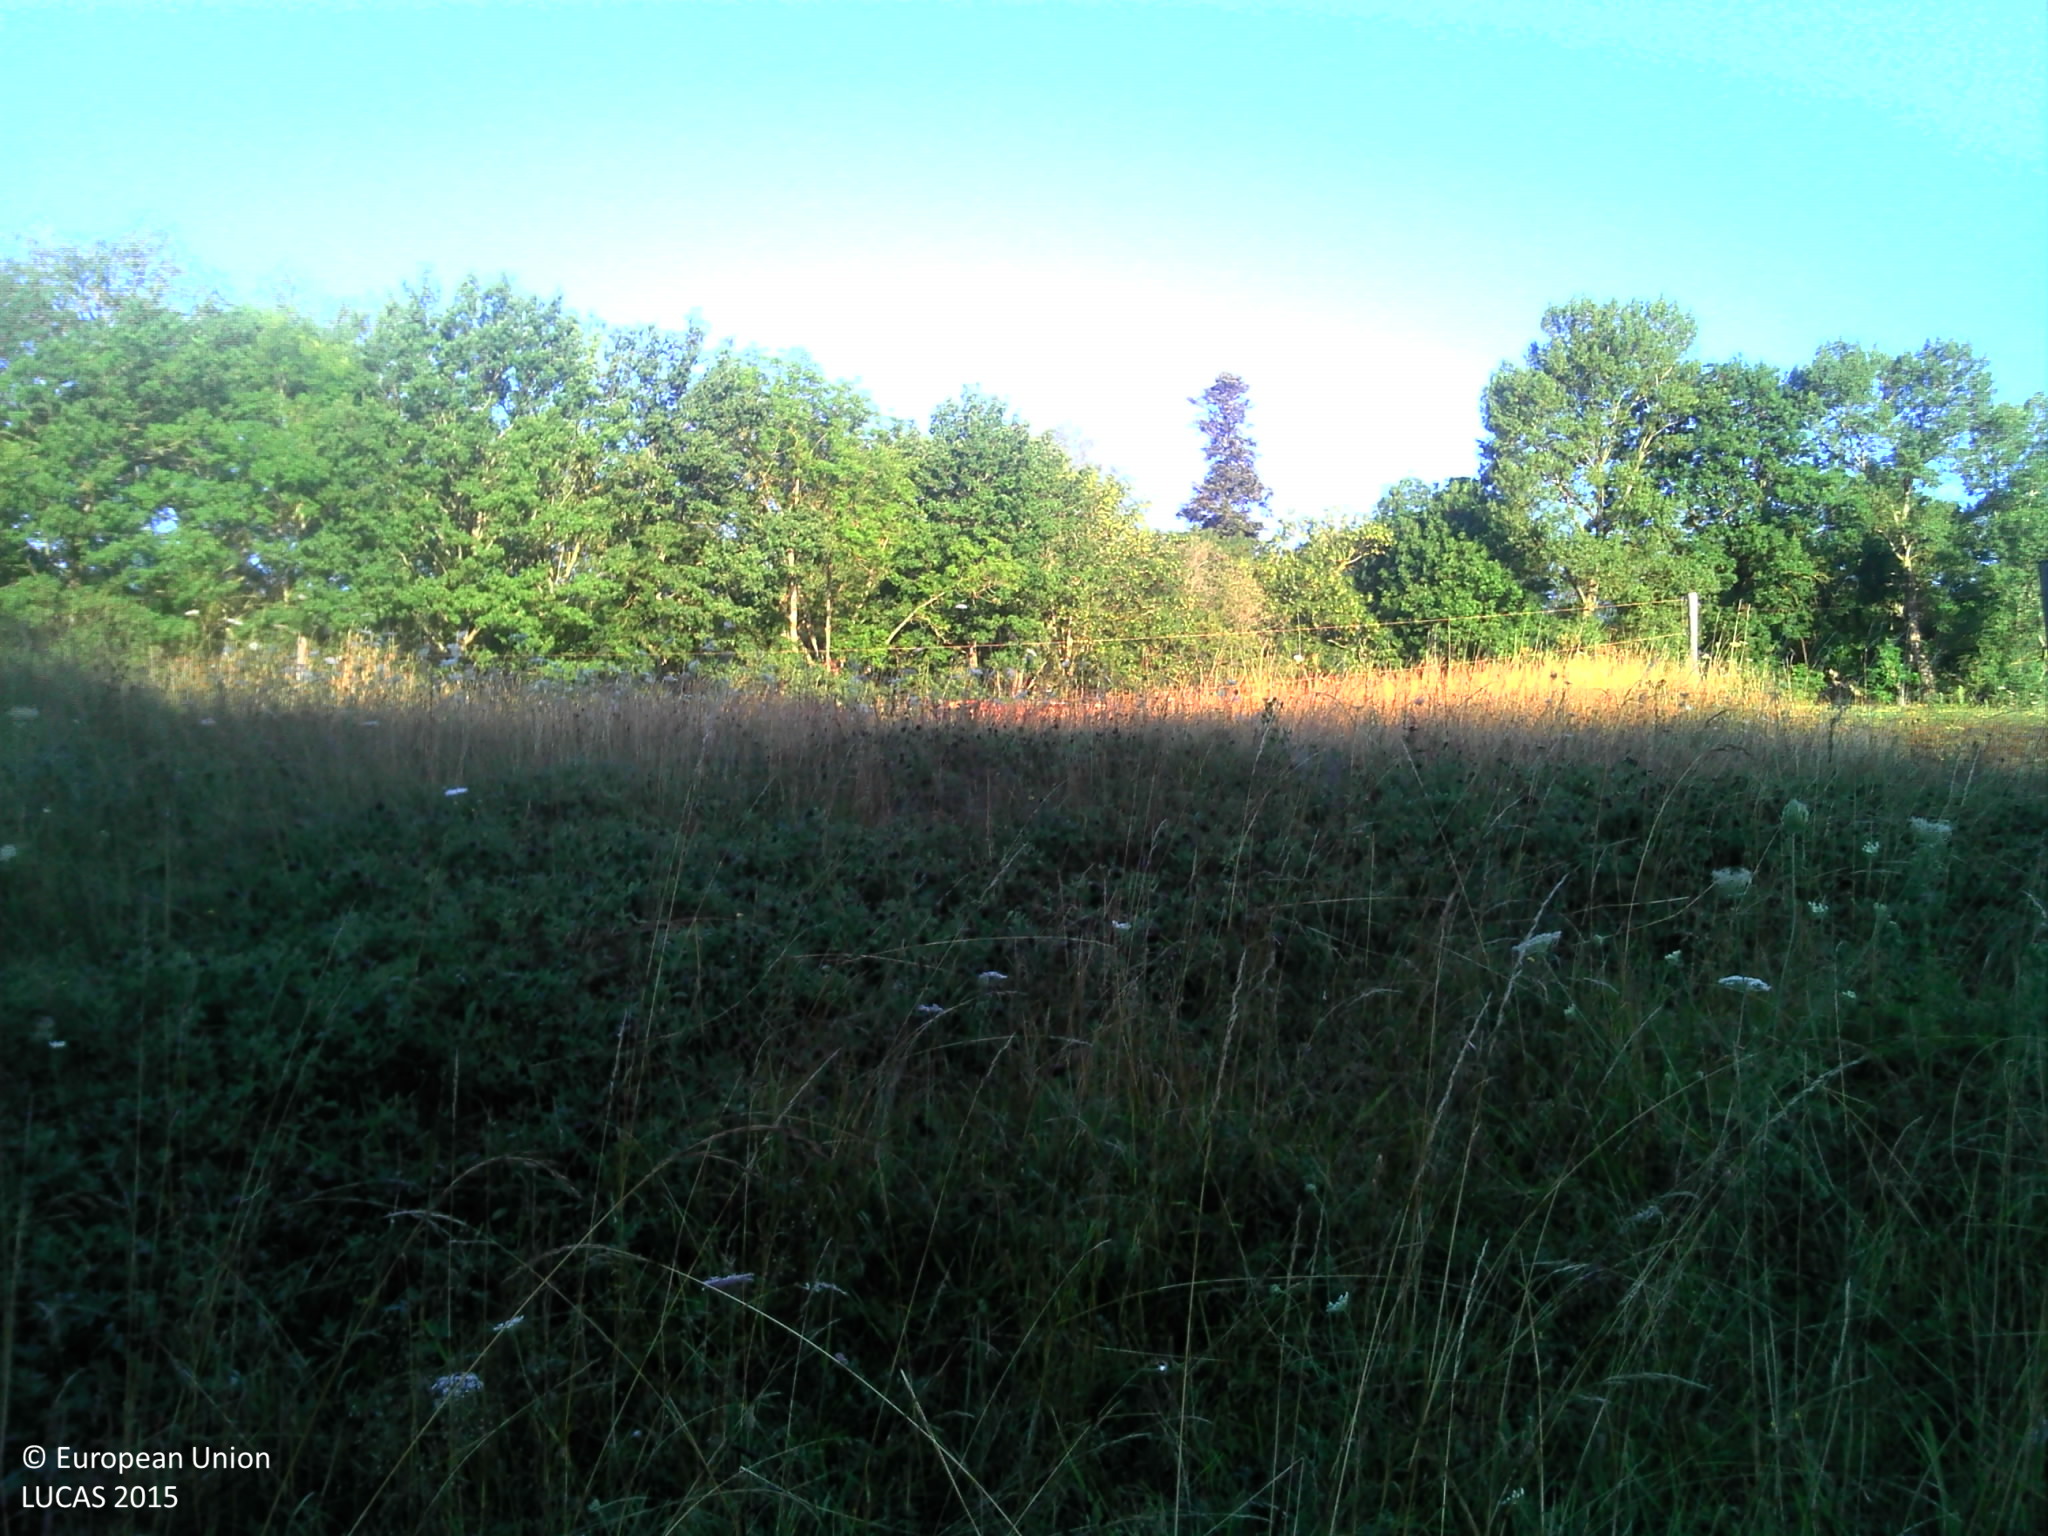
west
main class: Grassland
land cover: Grassland without tree/shrub cover
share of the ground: > 75 %
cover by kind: herbaceous plants 100 %
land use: Agriculture (excluding fallow land and kitchen gardens)
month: July
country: FR
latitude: 45.0523
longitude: 3.8203
